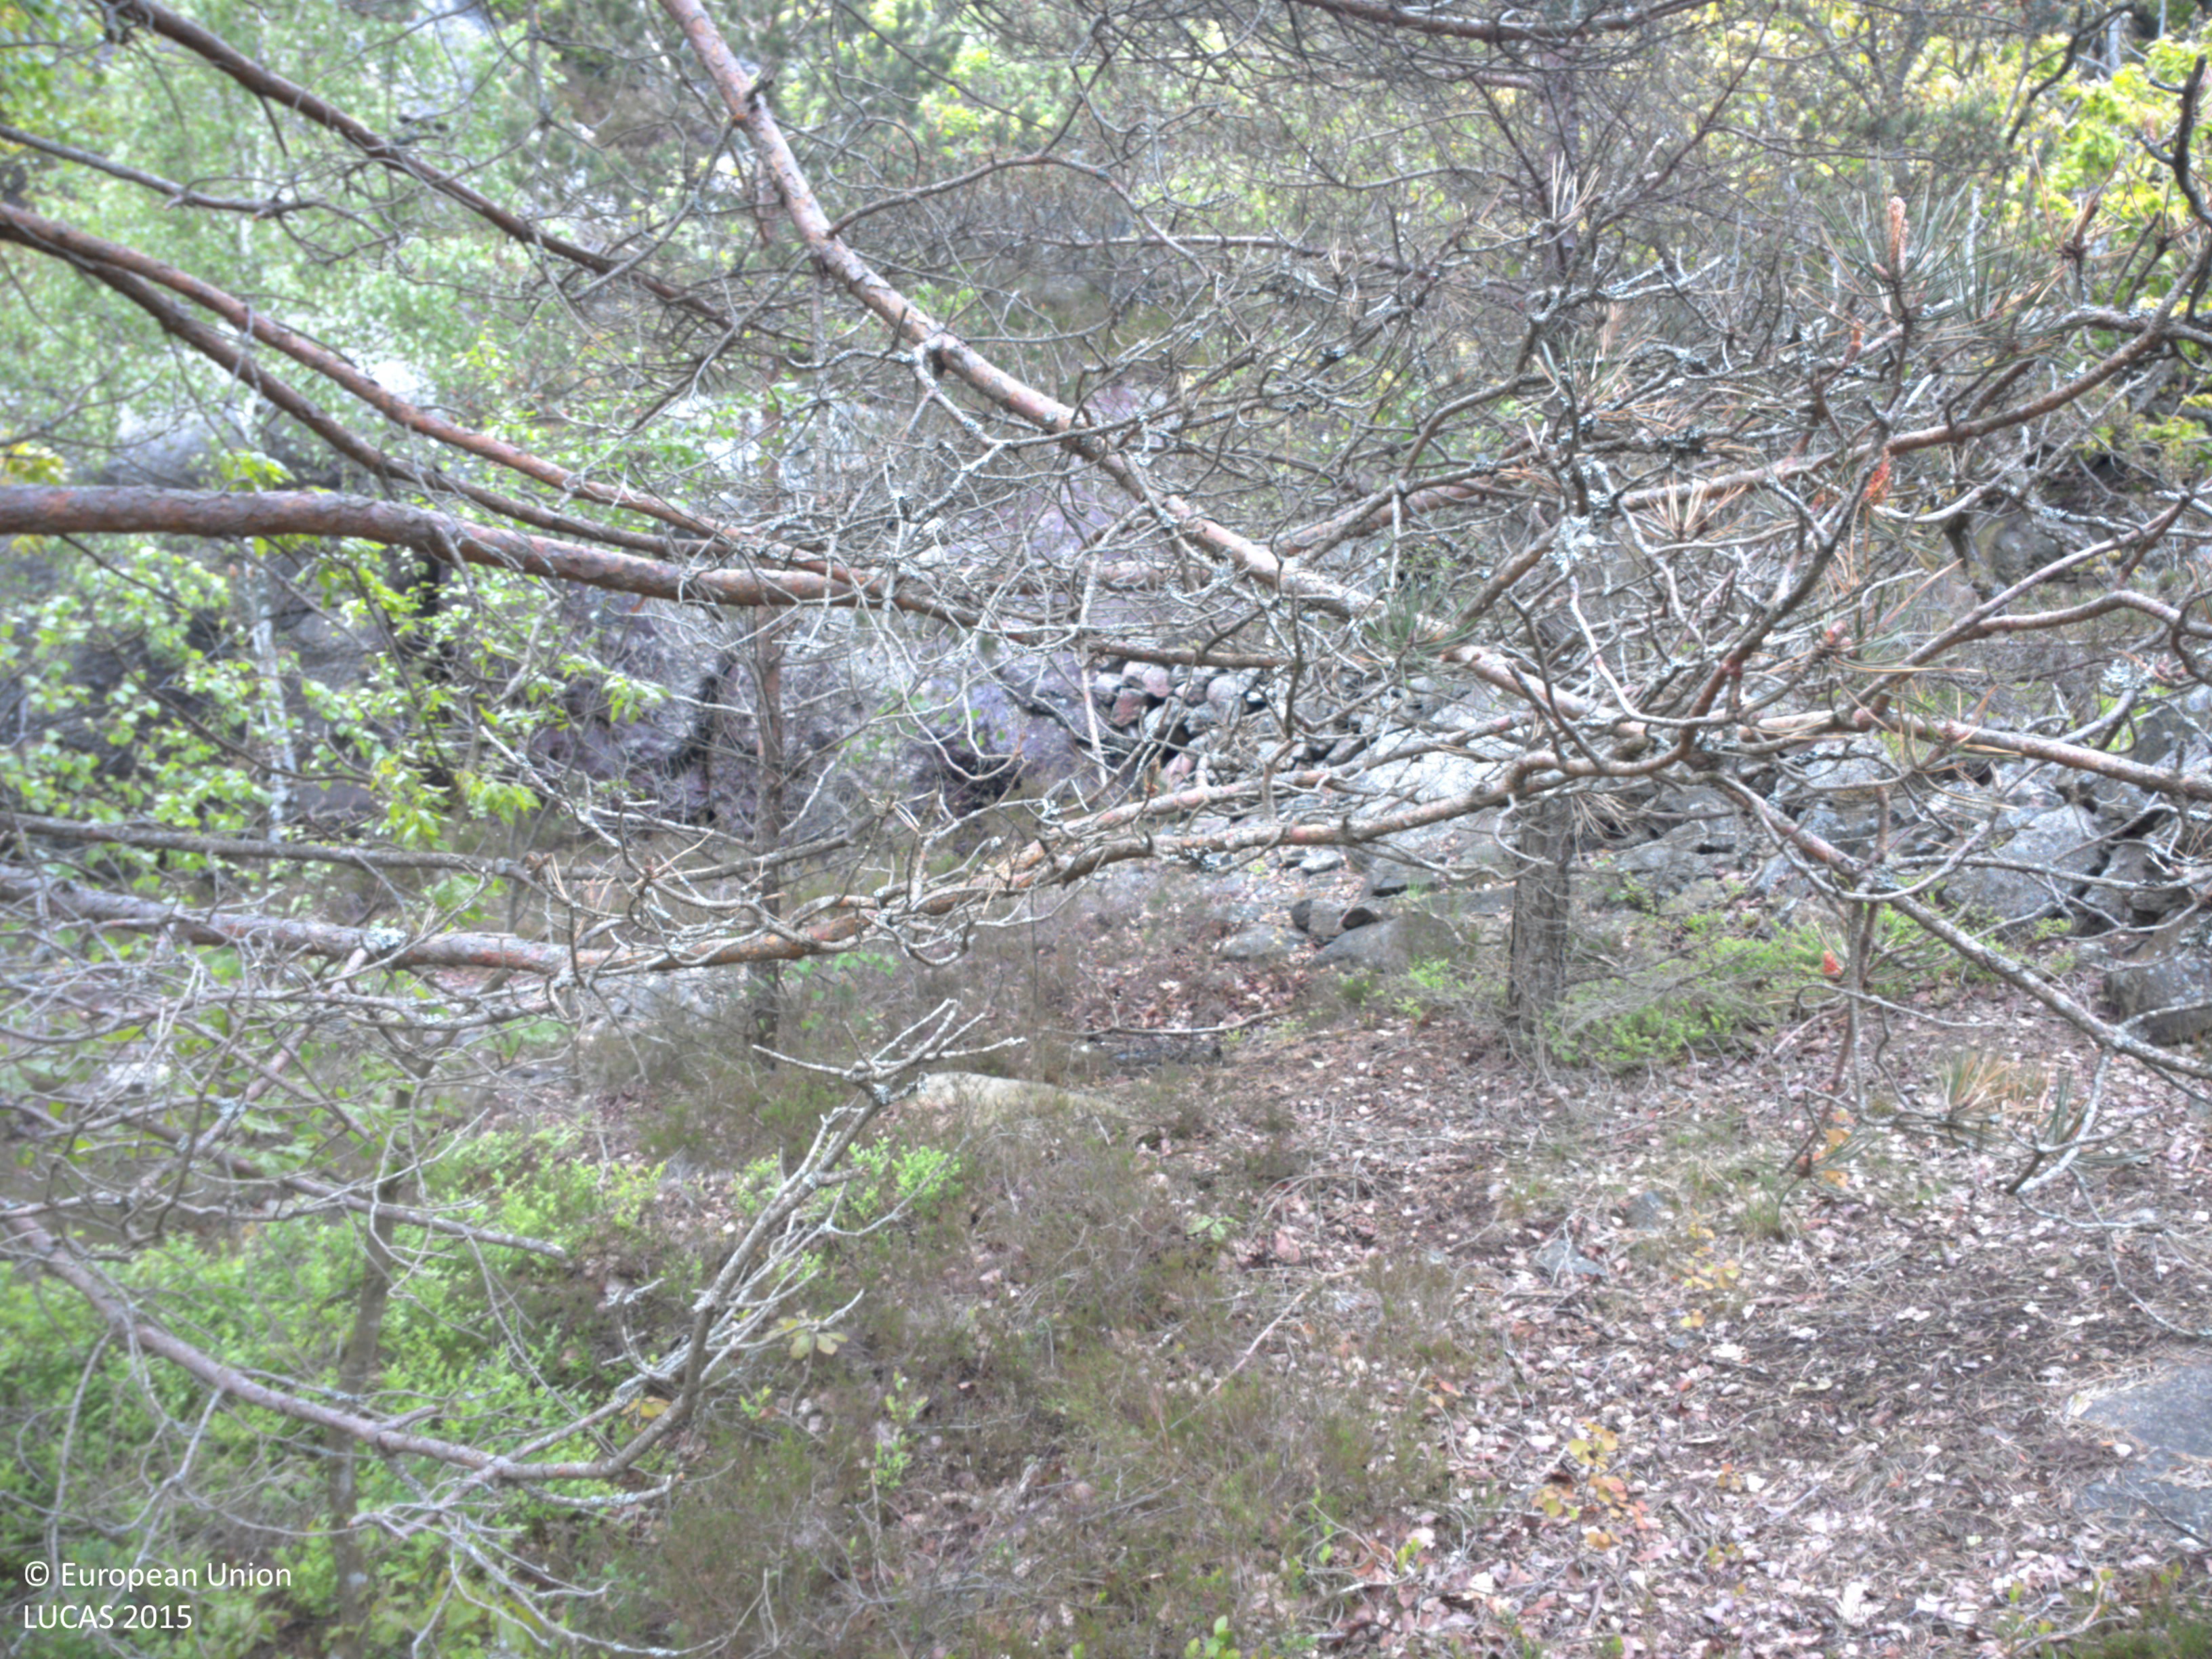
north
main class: Woodland
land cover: Other mixed woodland
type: hemiboreal forest and nemoral coniferous forest and mixed broadleaved-coniferous forest
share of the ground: 50 - 75 %
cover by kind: broadleaved forest trees 40 %, coniferous forest trees 20 %, shrubs 20 %, herbaceous plants 20 %
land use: Forestry
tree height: > 5 m
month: May
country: SE
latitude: 58.2278
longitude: 11.6144
